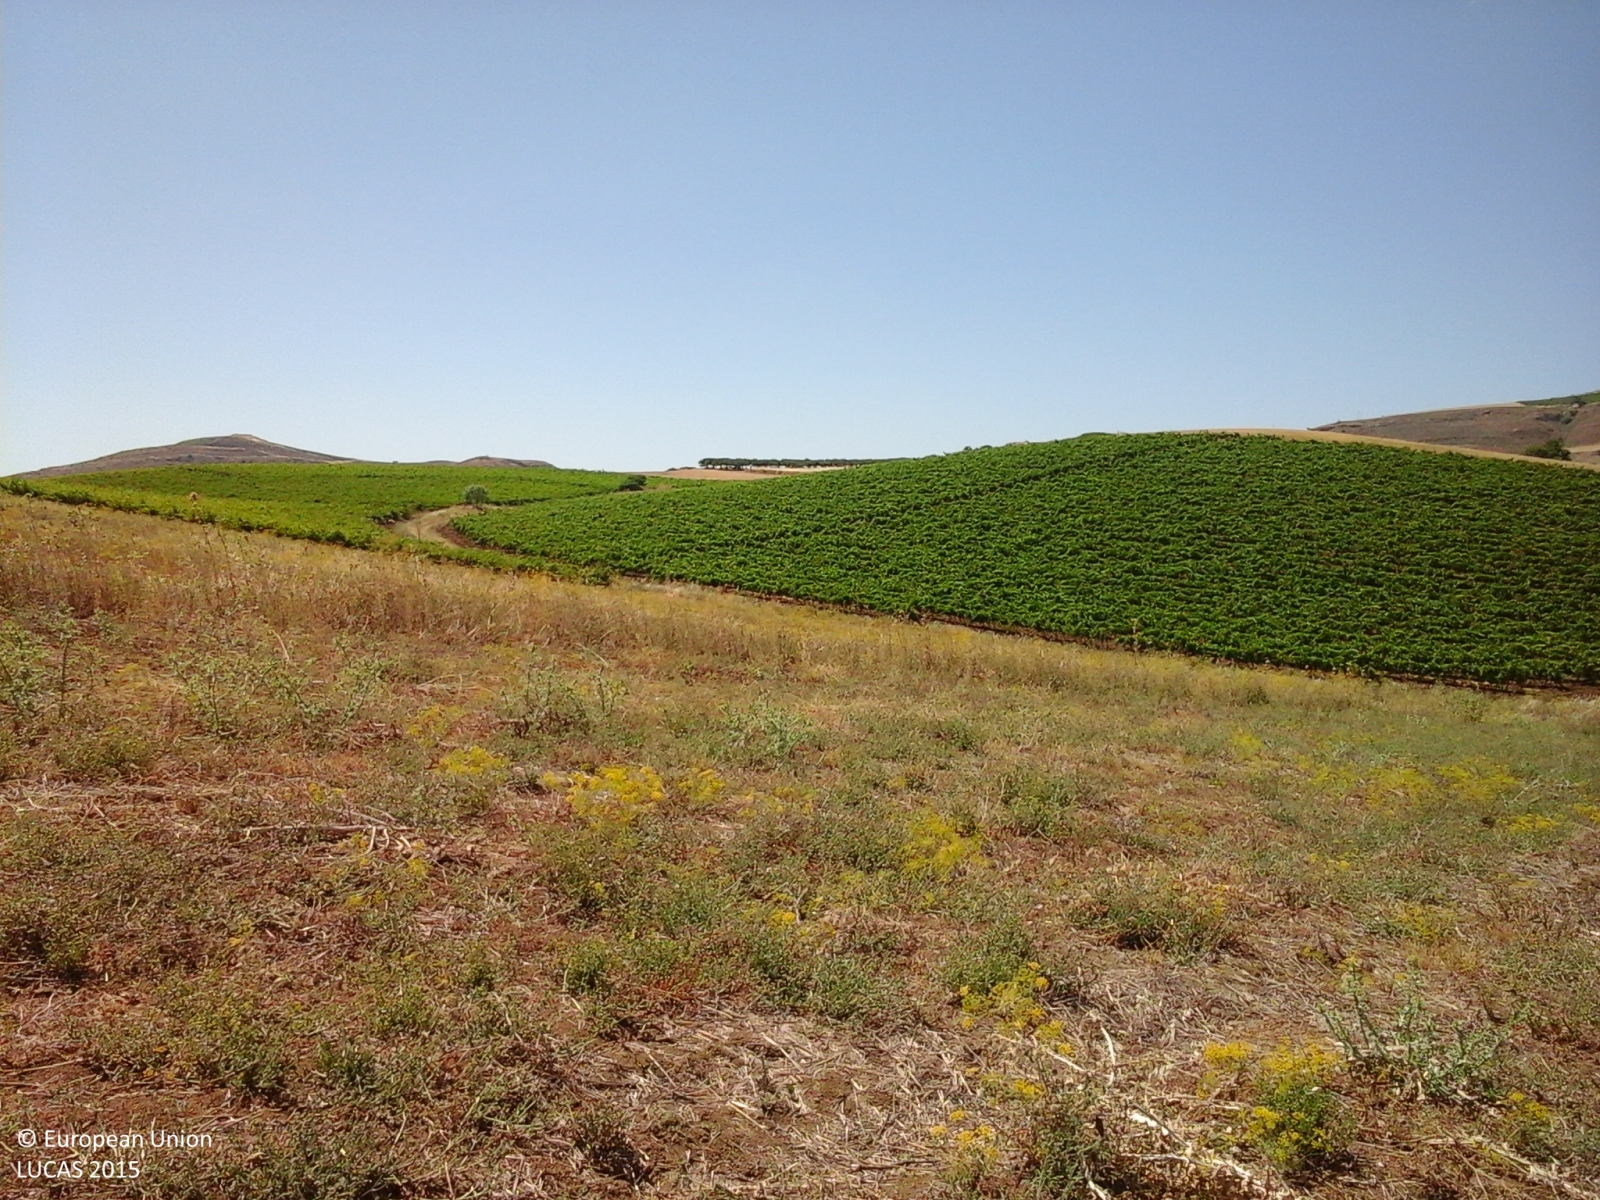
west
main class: Grassland
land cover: Spontaneously vegetated surfaces
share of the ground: > 75 %
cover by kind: herbaceous plants 100 %
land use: Agriculture (excluding fallow land and kitchen gardens)
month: June
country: IT
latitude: 37.7976
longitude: 12.7844
